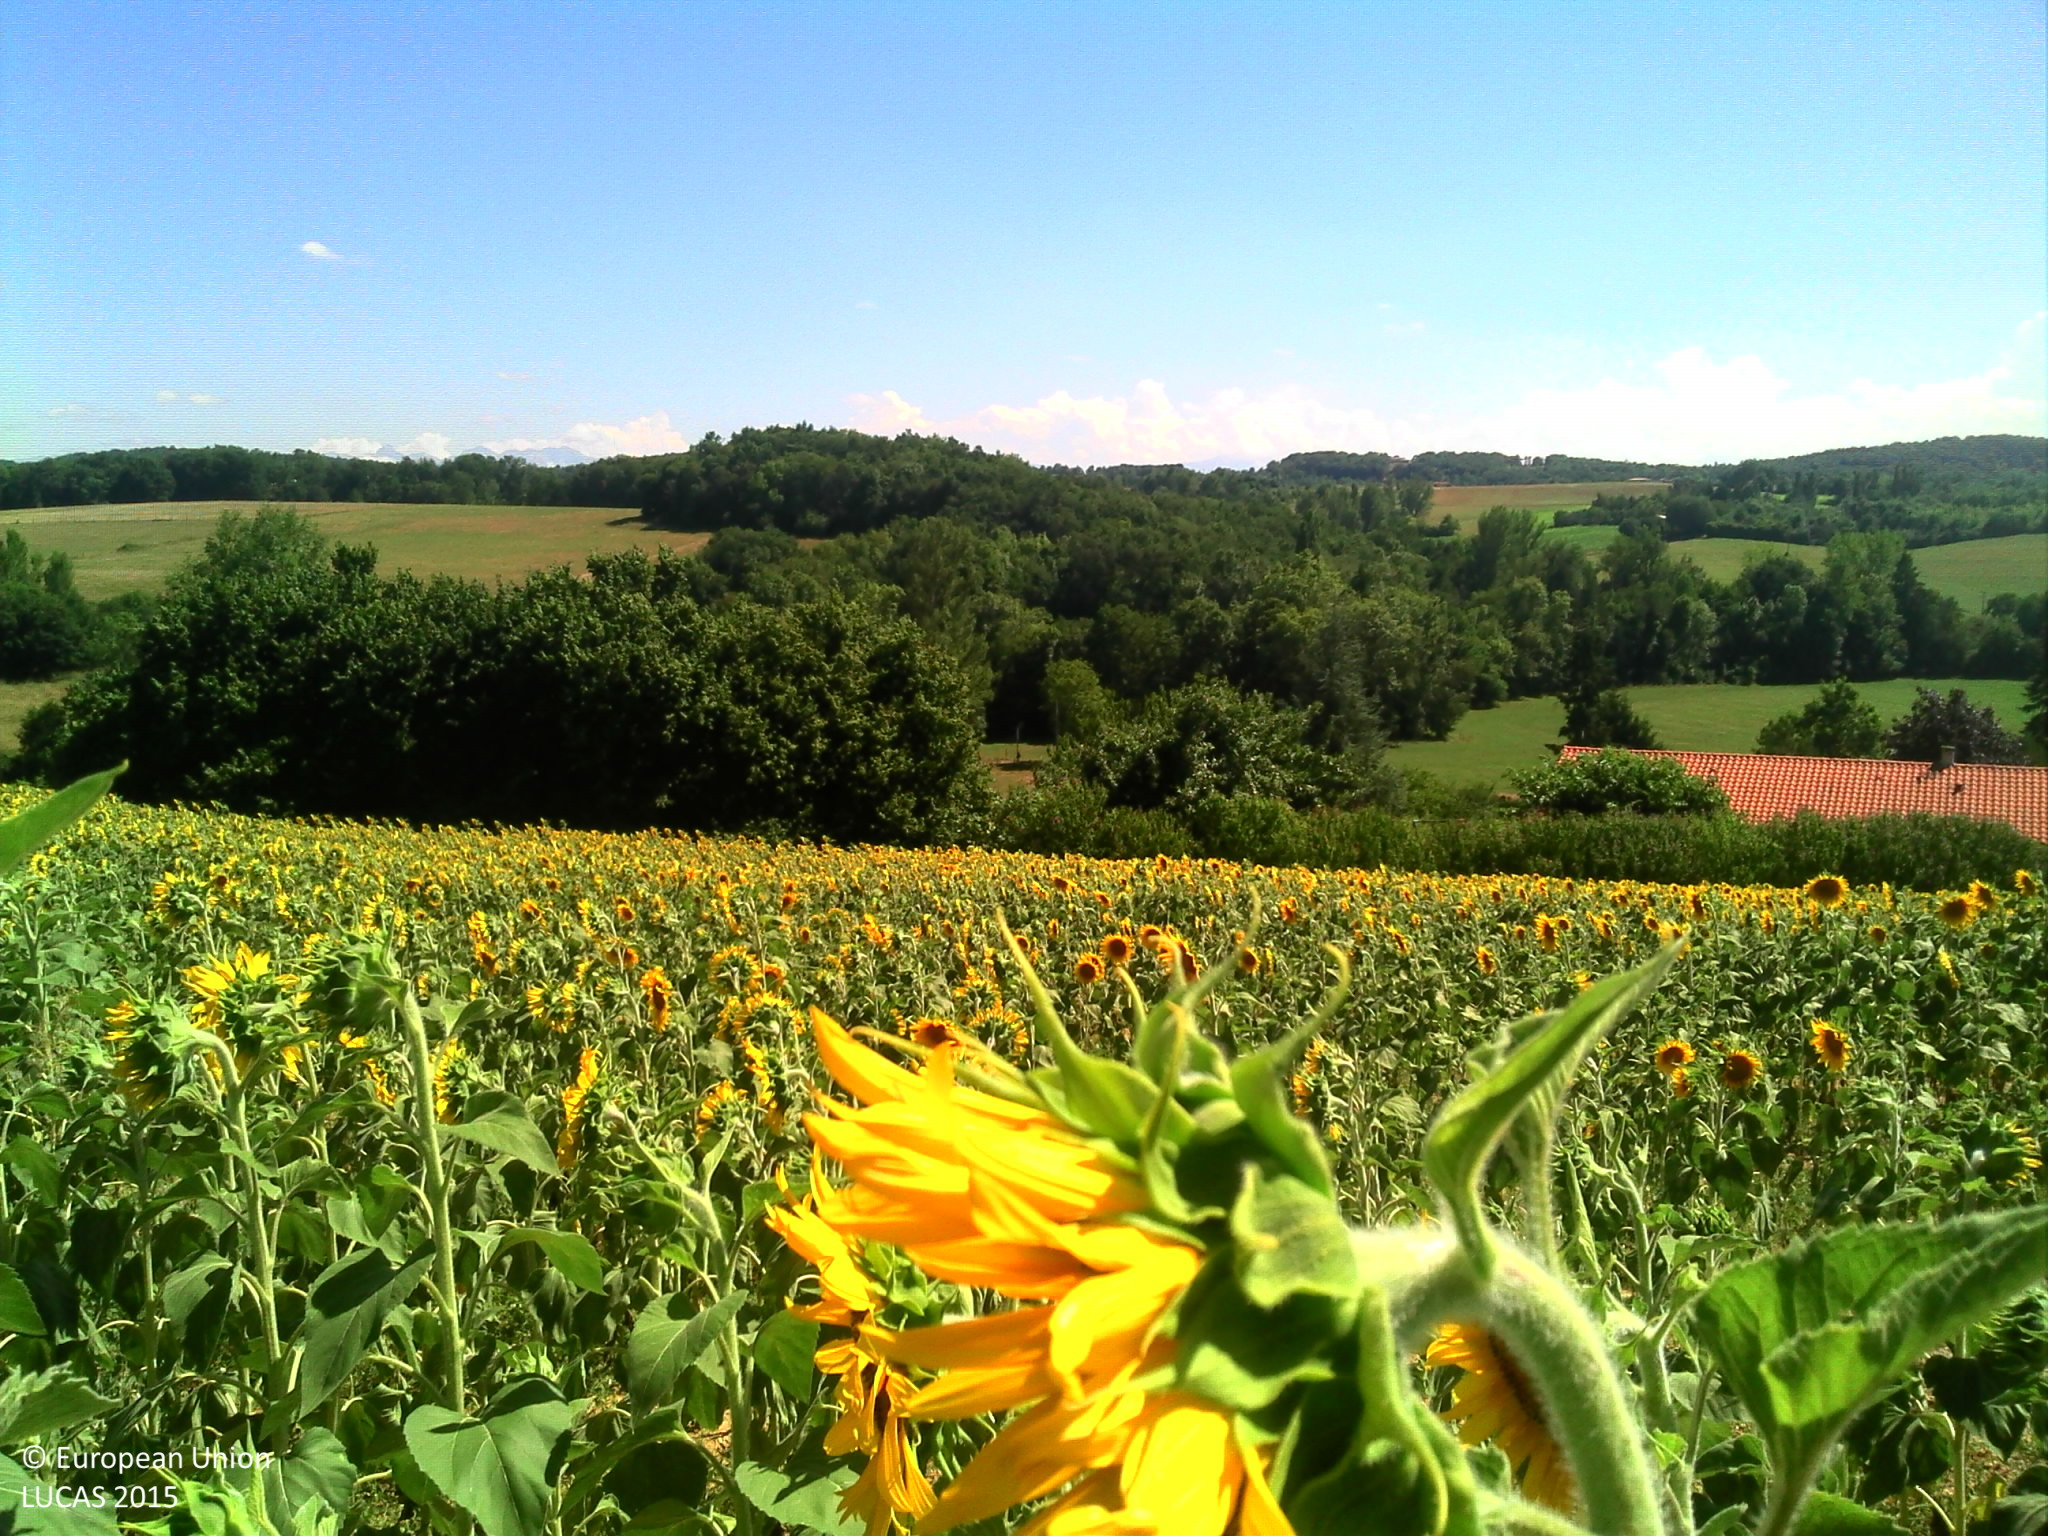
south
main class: Cropland
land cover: Sunflower
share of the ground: > 75 %
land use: Agriculture (excluding fallow land and kitchen gardens)
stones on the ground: < 10 %
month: July
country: FR
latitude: 43.2113
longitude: 0.7573
